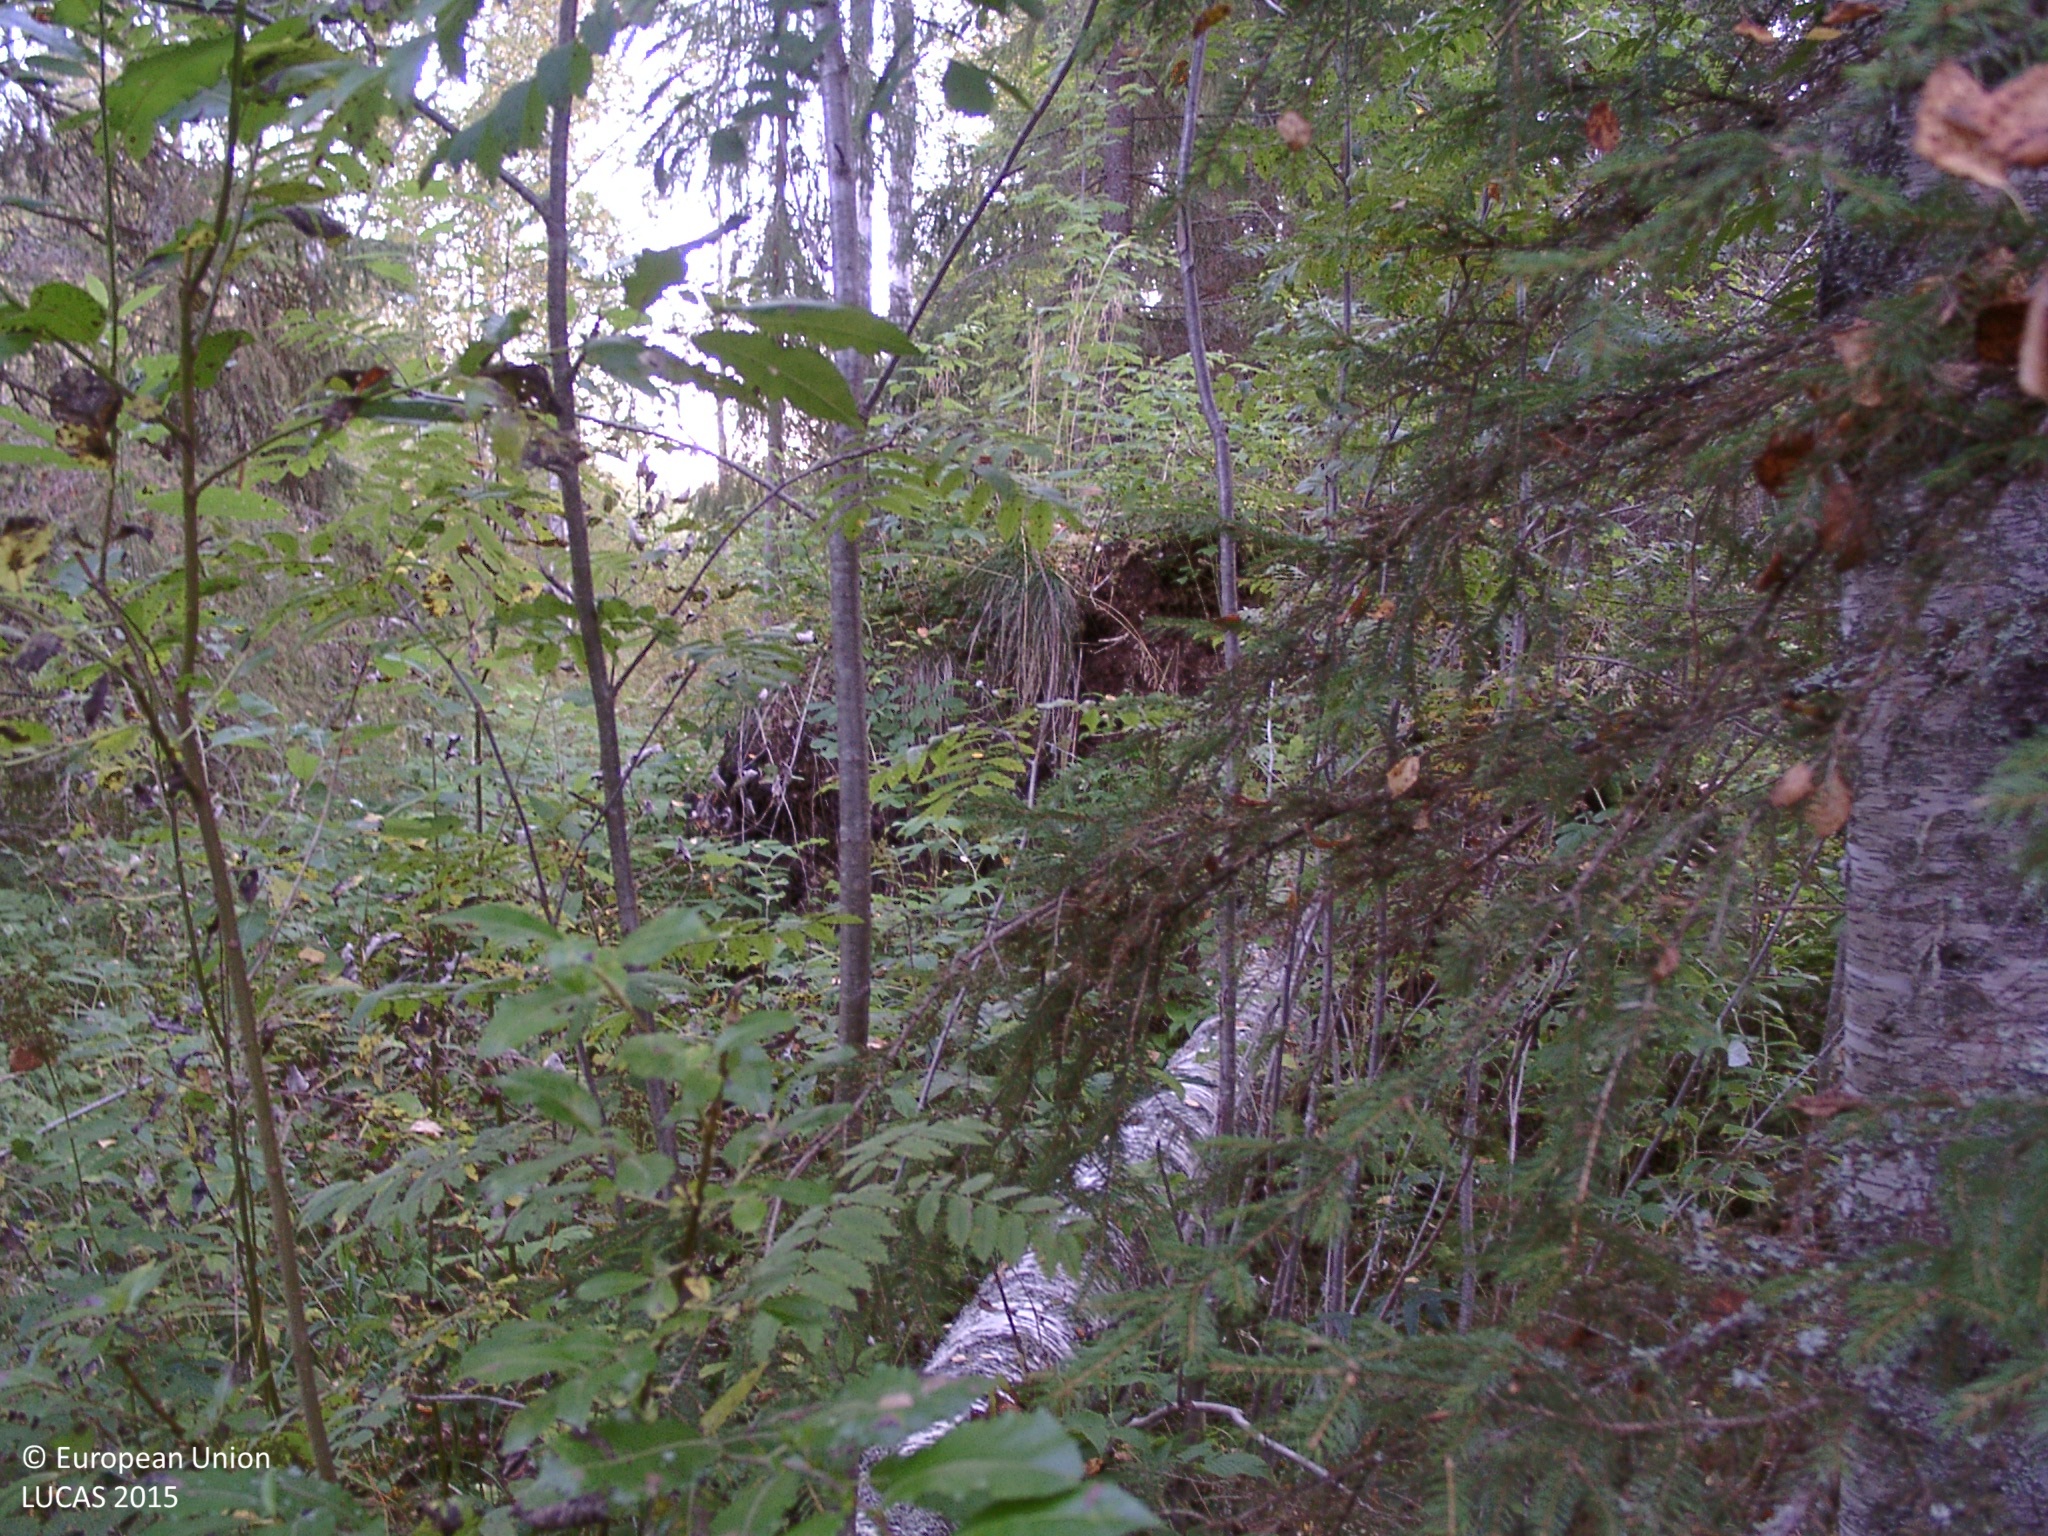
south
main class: Woodland
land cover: Spruce dominated mixed woodland
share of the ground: 25 - 50 %
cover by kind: shrubs 40 %, herbaceous plants 25 %, broadleaved forest trees 20 %, coniferous forest trees 15 %
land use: Forestry
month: September
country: FI
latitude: 62.4316
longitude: 24.7574
